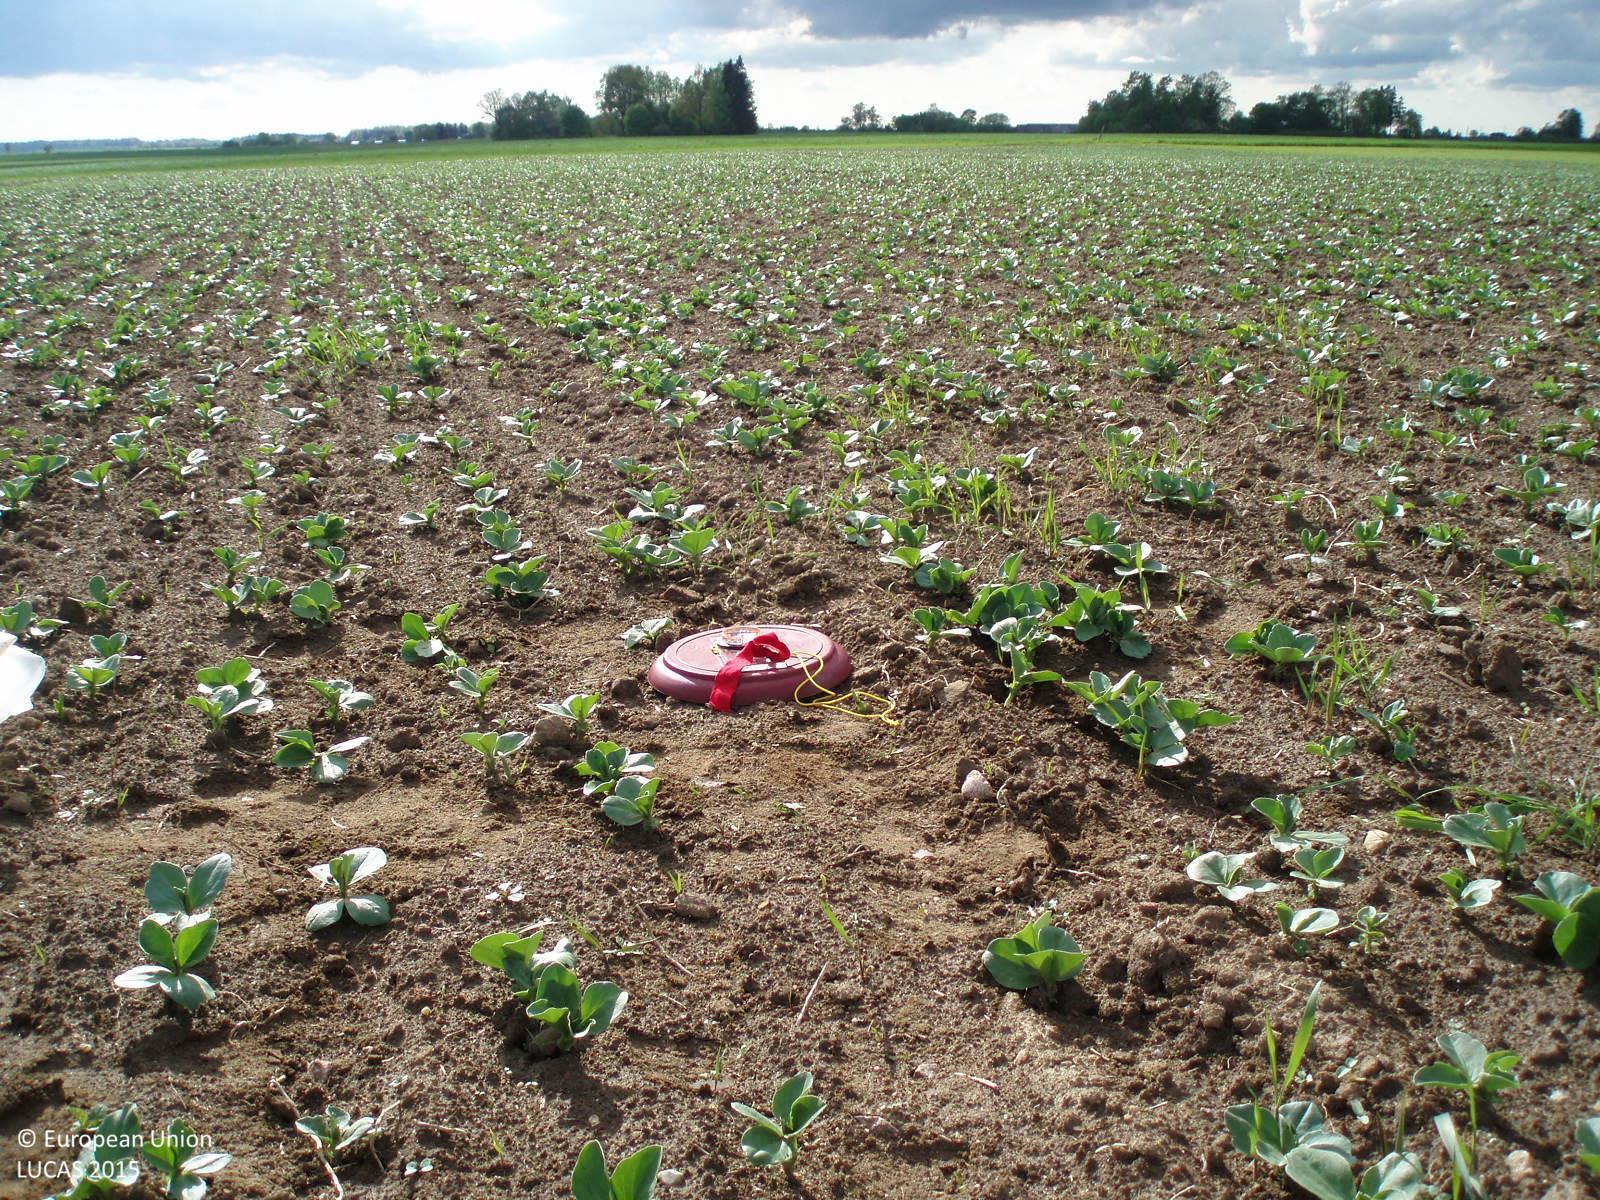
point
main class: Cropland
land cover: Dry pulses
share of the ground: 25 - 50 %
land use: Agriculture (excluding fallow land and kitchen gardens)
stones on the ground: < 10 %
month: May
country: LT
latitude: 56.3680
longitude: 22.5732
